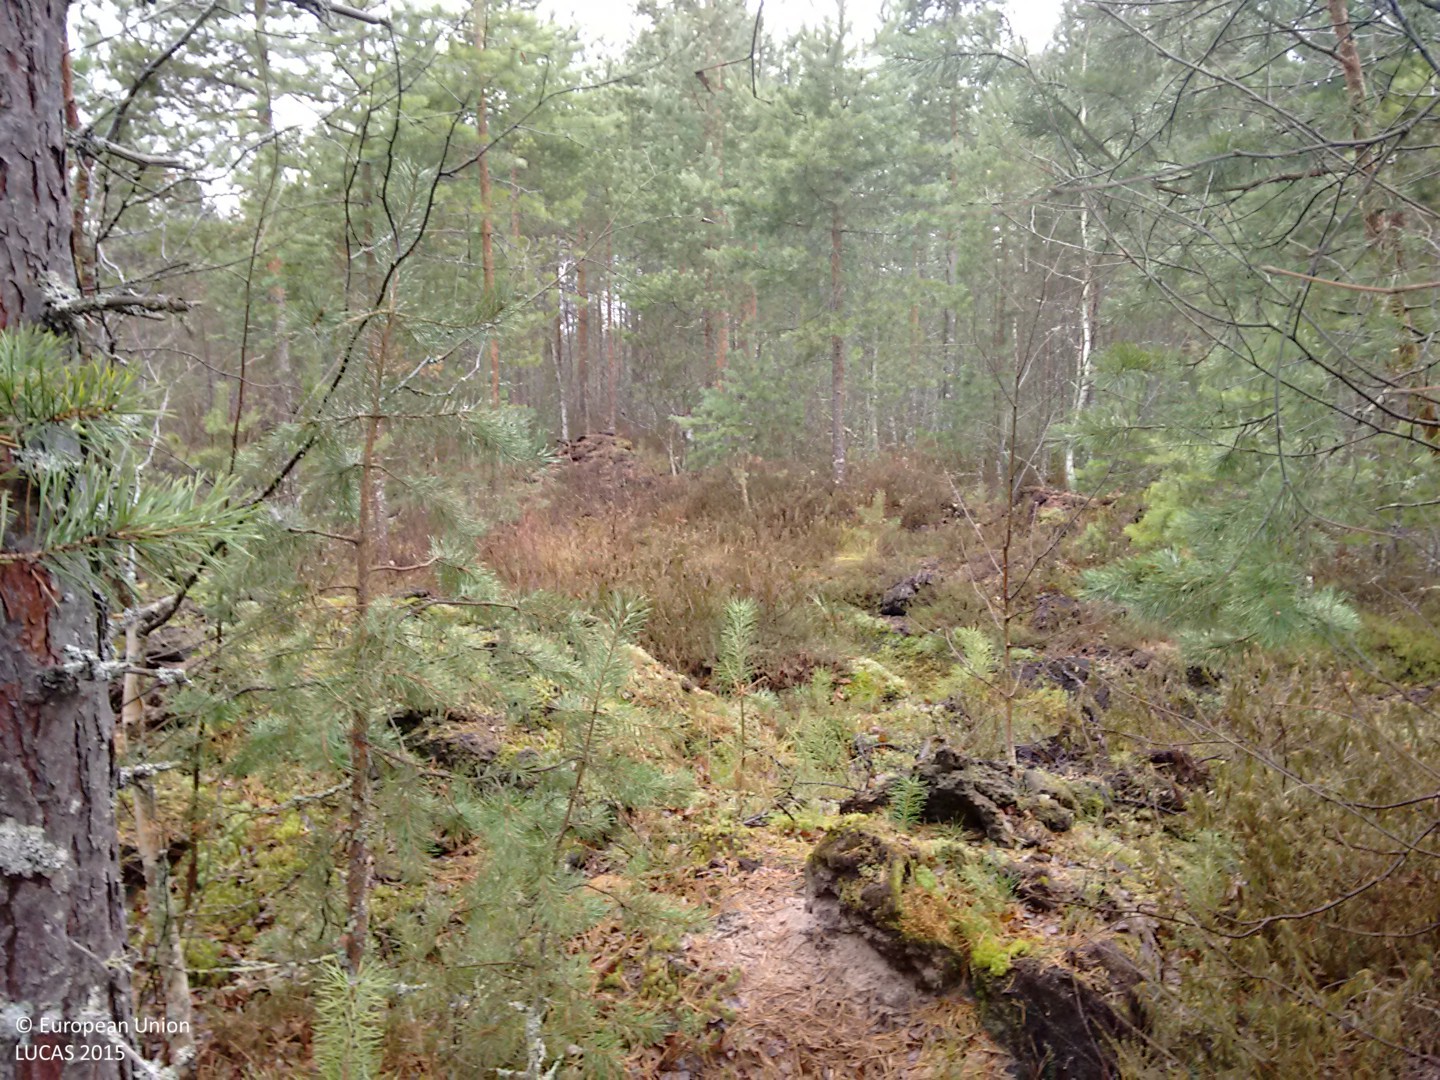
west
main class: Woodland
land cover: Pine dominated coniferous woodland
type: boreal forest
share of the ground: > 75 %
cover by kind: coniferous forest trees 60 %, shrubs 20 %, broadleaved forest trees 15 %, herbaceous plants 5 %
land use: Forestry
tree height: > 5 m
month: October
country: FI
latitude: 64.5947
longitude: 24.8872
